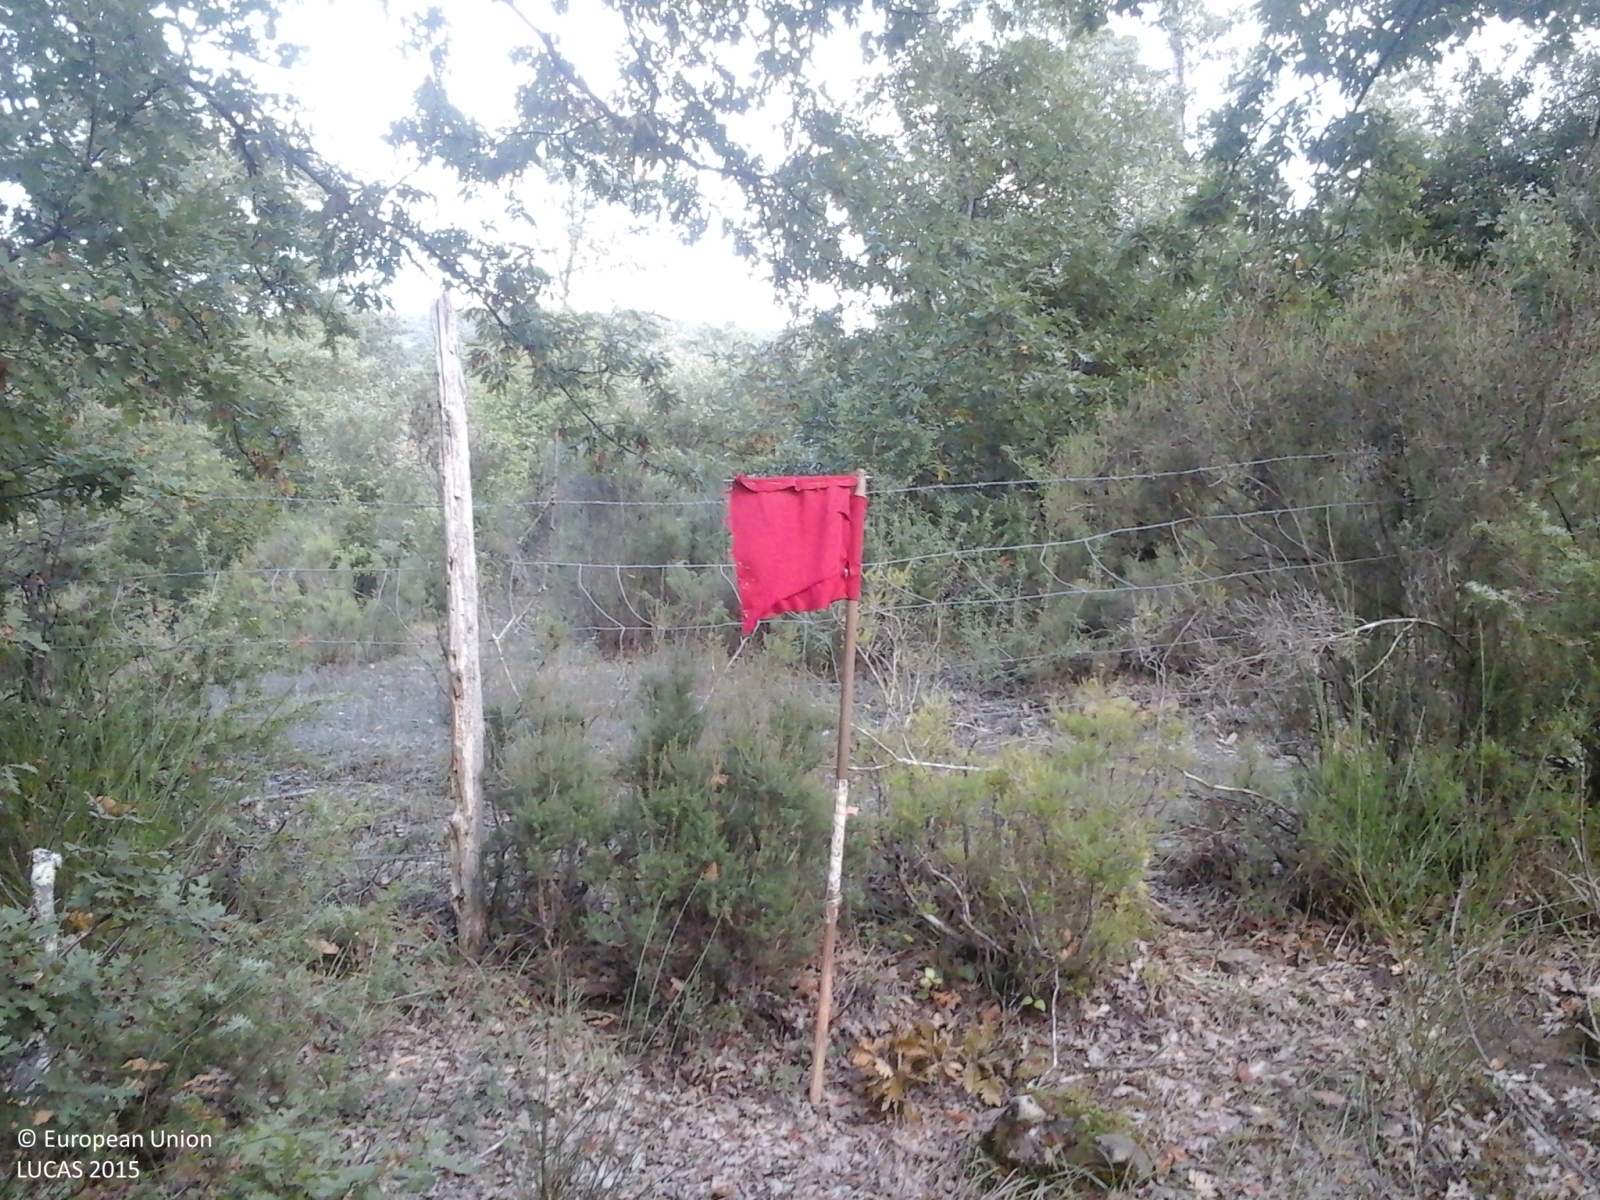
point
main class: Woodland
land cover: Broadleaved woodland
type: thermophilous deciduous forest
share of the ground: > 75 %
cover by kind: broadleaved forest trees 90 %, shrubs 10 %
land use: Forestry
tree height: > 5 m
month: October
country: IT
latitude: 43.3721
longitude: 12.1292
